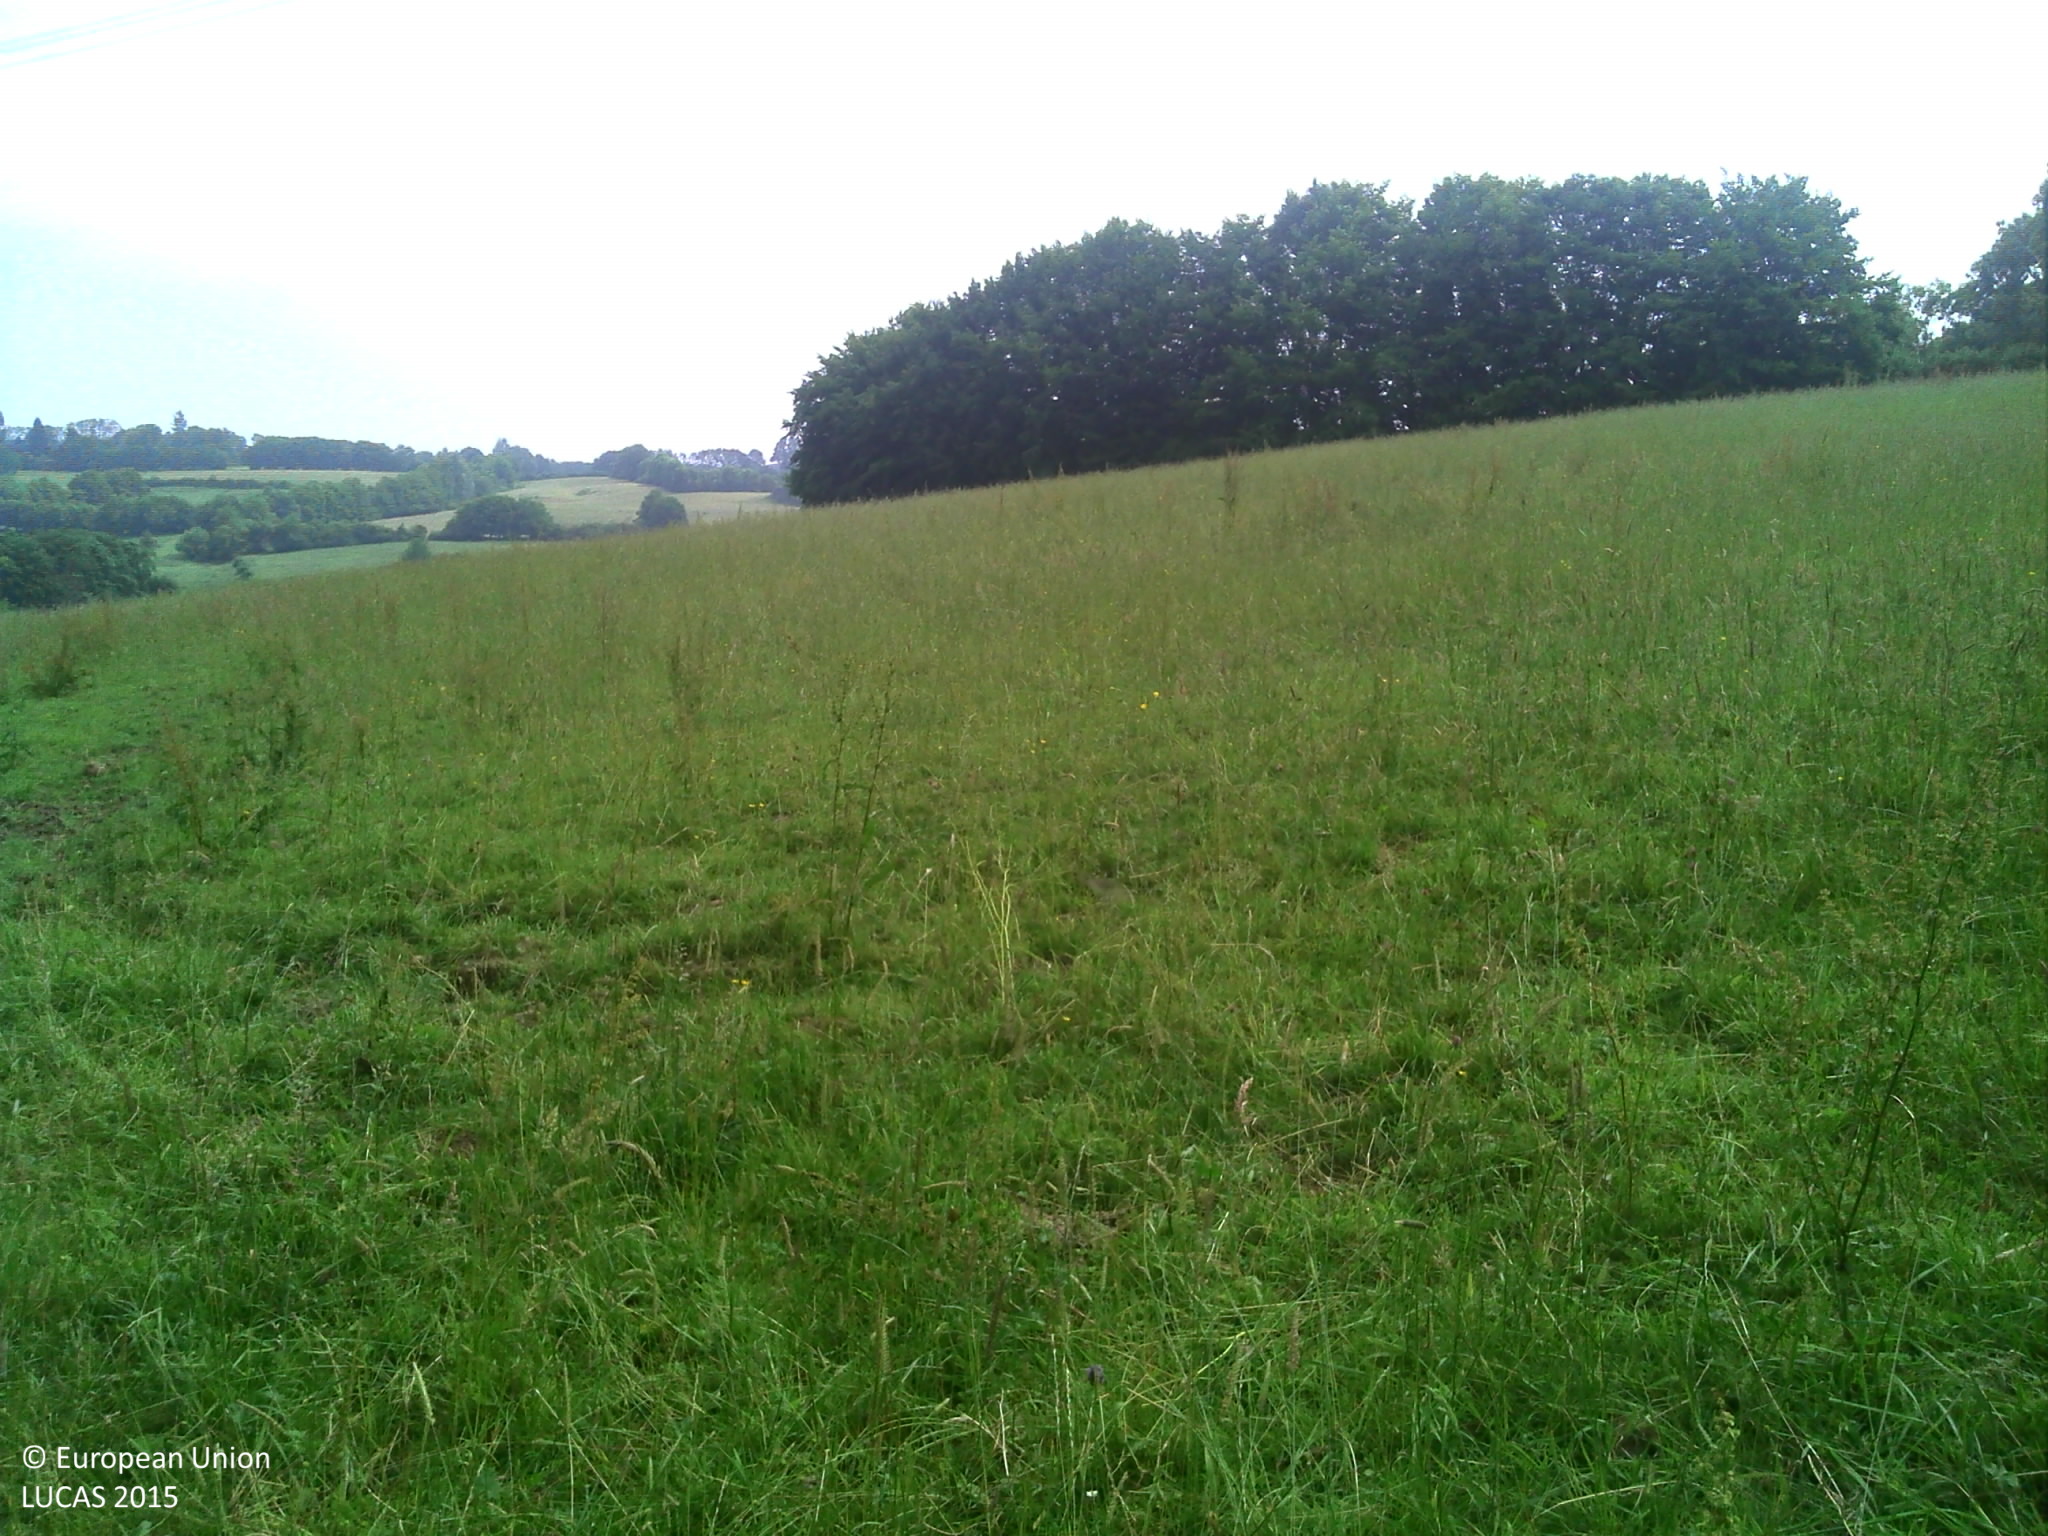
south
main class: Grassland
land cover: Grassland without tree/shrub cover
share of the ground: > 75 %
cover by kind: herbaceous plants 100 %
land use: Agriculture (excluding fallow land and kitchen gardens)
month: June
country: FR
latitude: 49.9176
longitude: 3.9918
